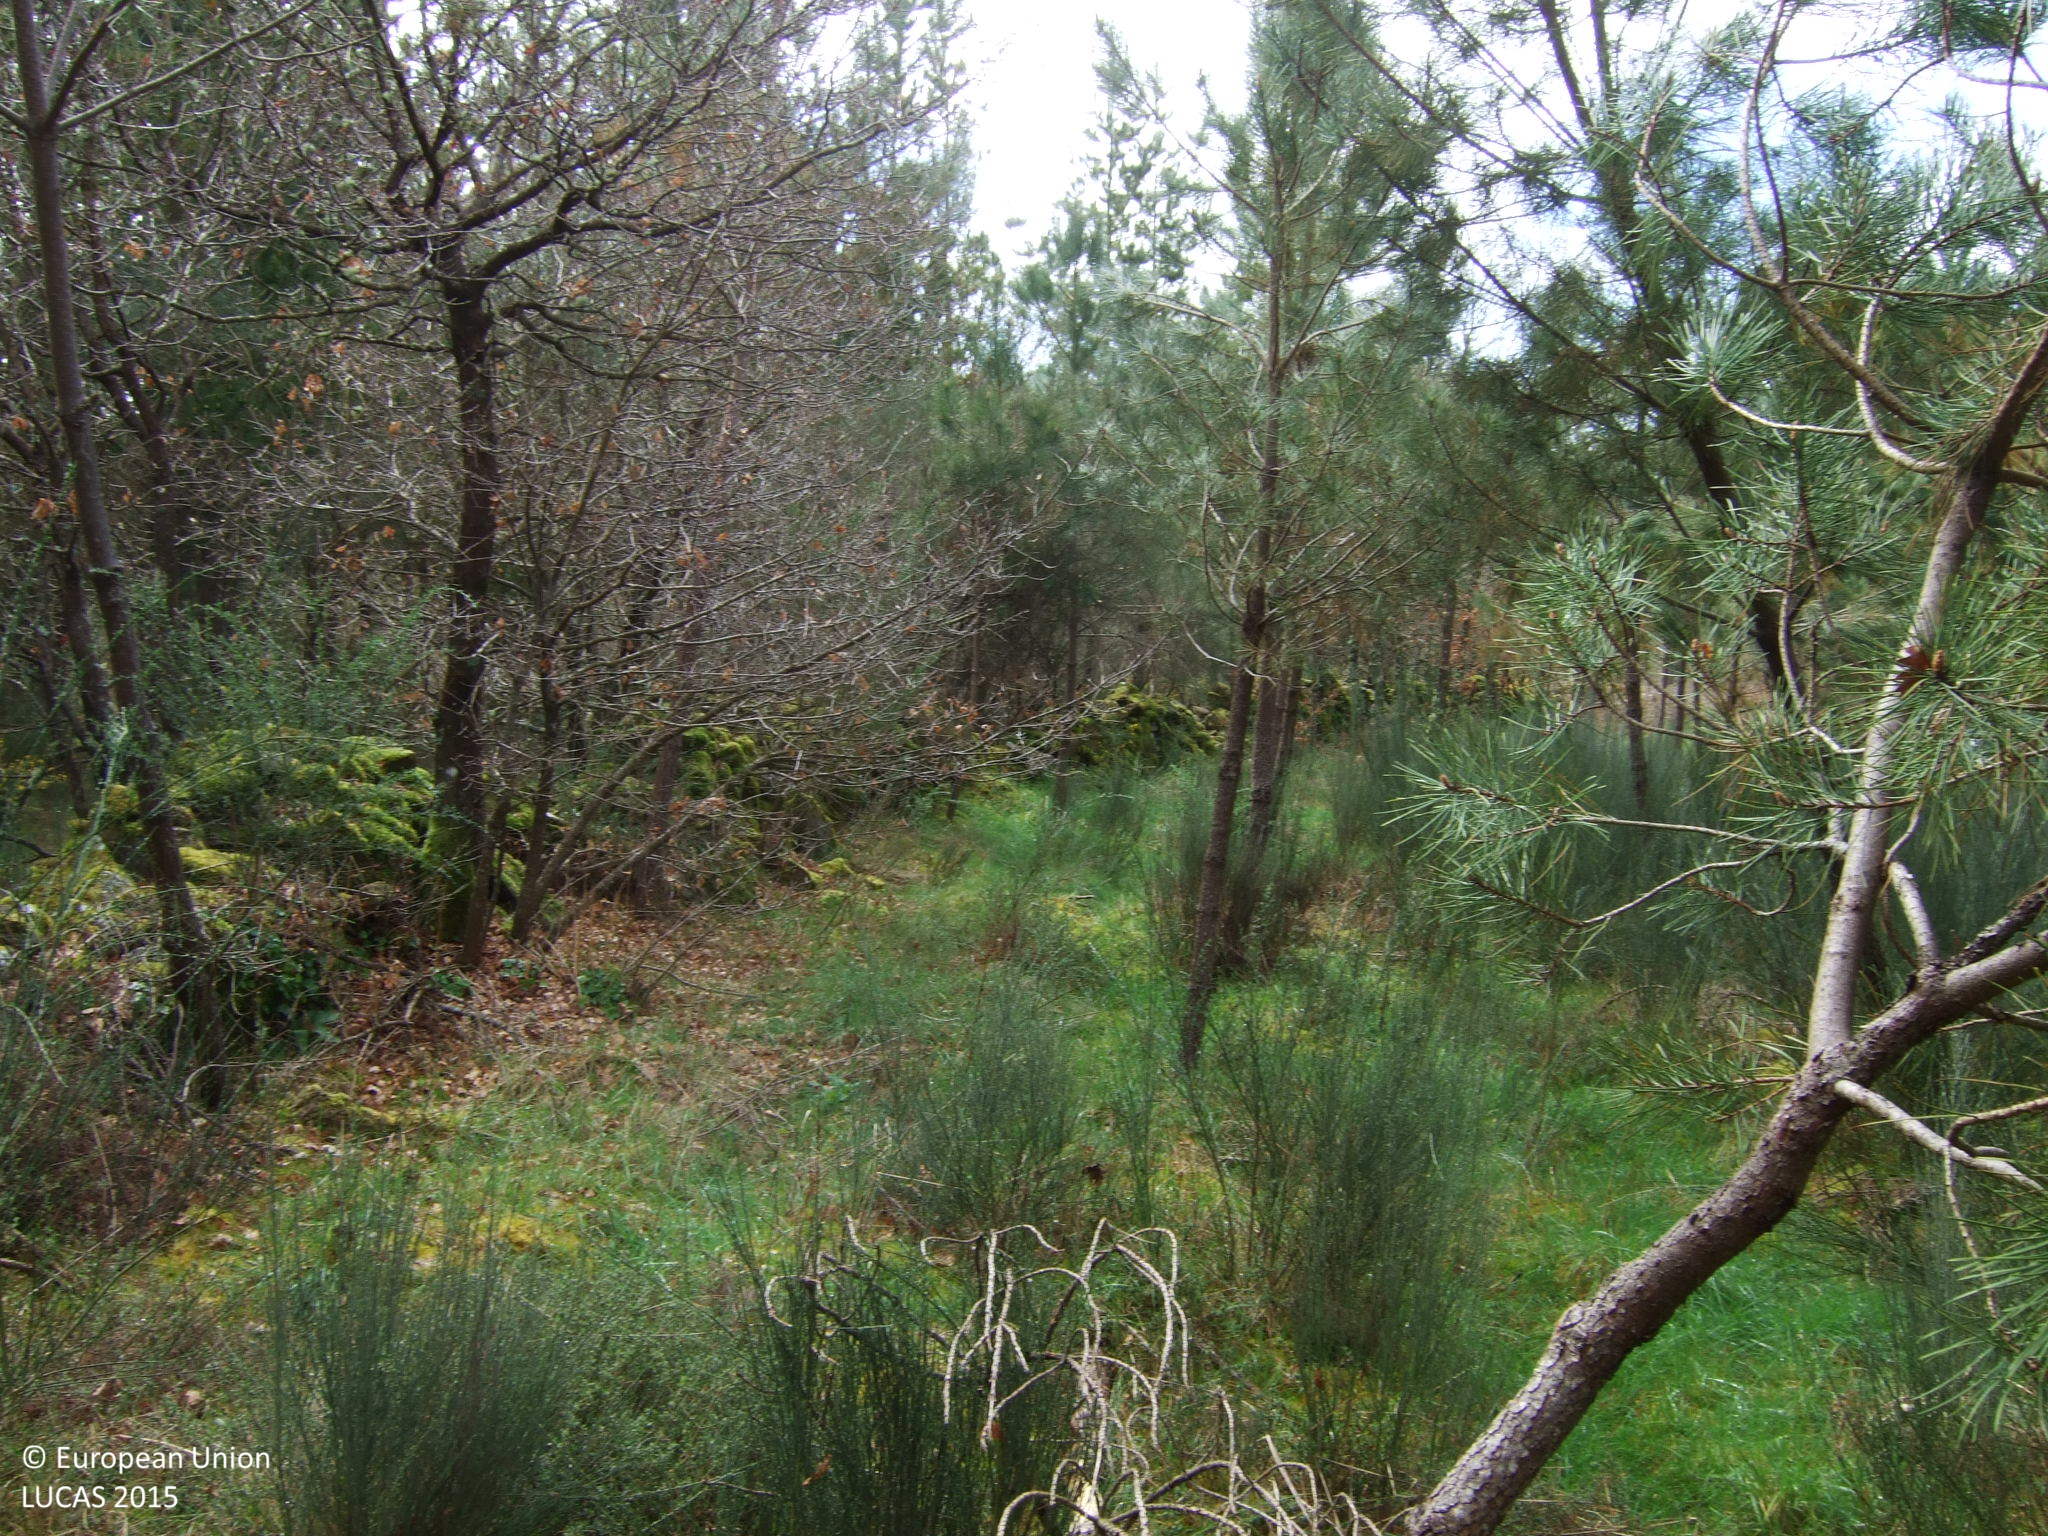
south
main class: Woodland
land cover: Pine dominated coniferous woodland
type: exotic forest
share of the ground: > 75 %
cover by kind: coniferous forest trees 80 %, shrubs 10 %, herbaceous plants 10 %
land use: Forestry
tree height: > 5 m
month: March
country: ES
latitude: 42.8099
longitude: -7.8267
